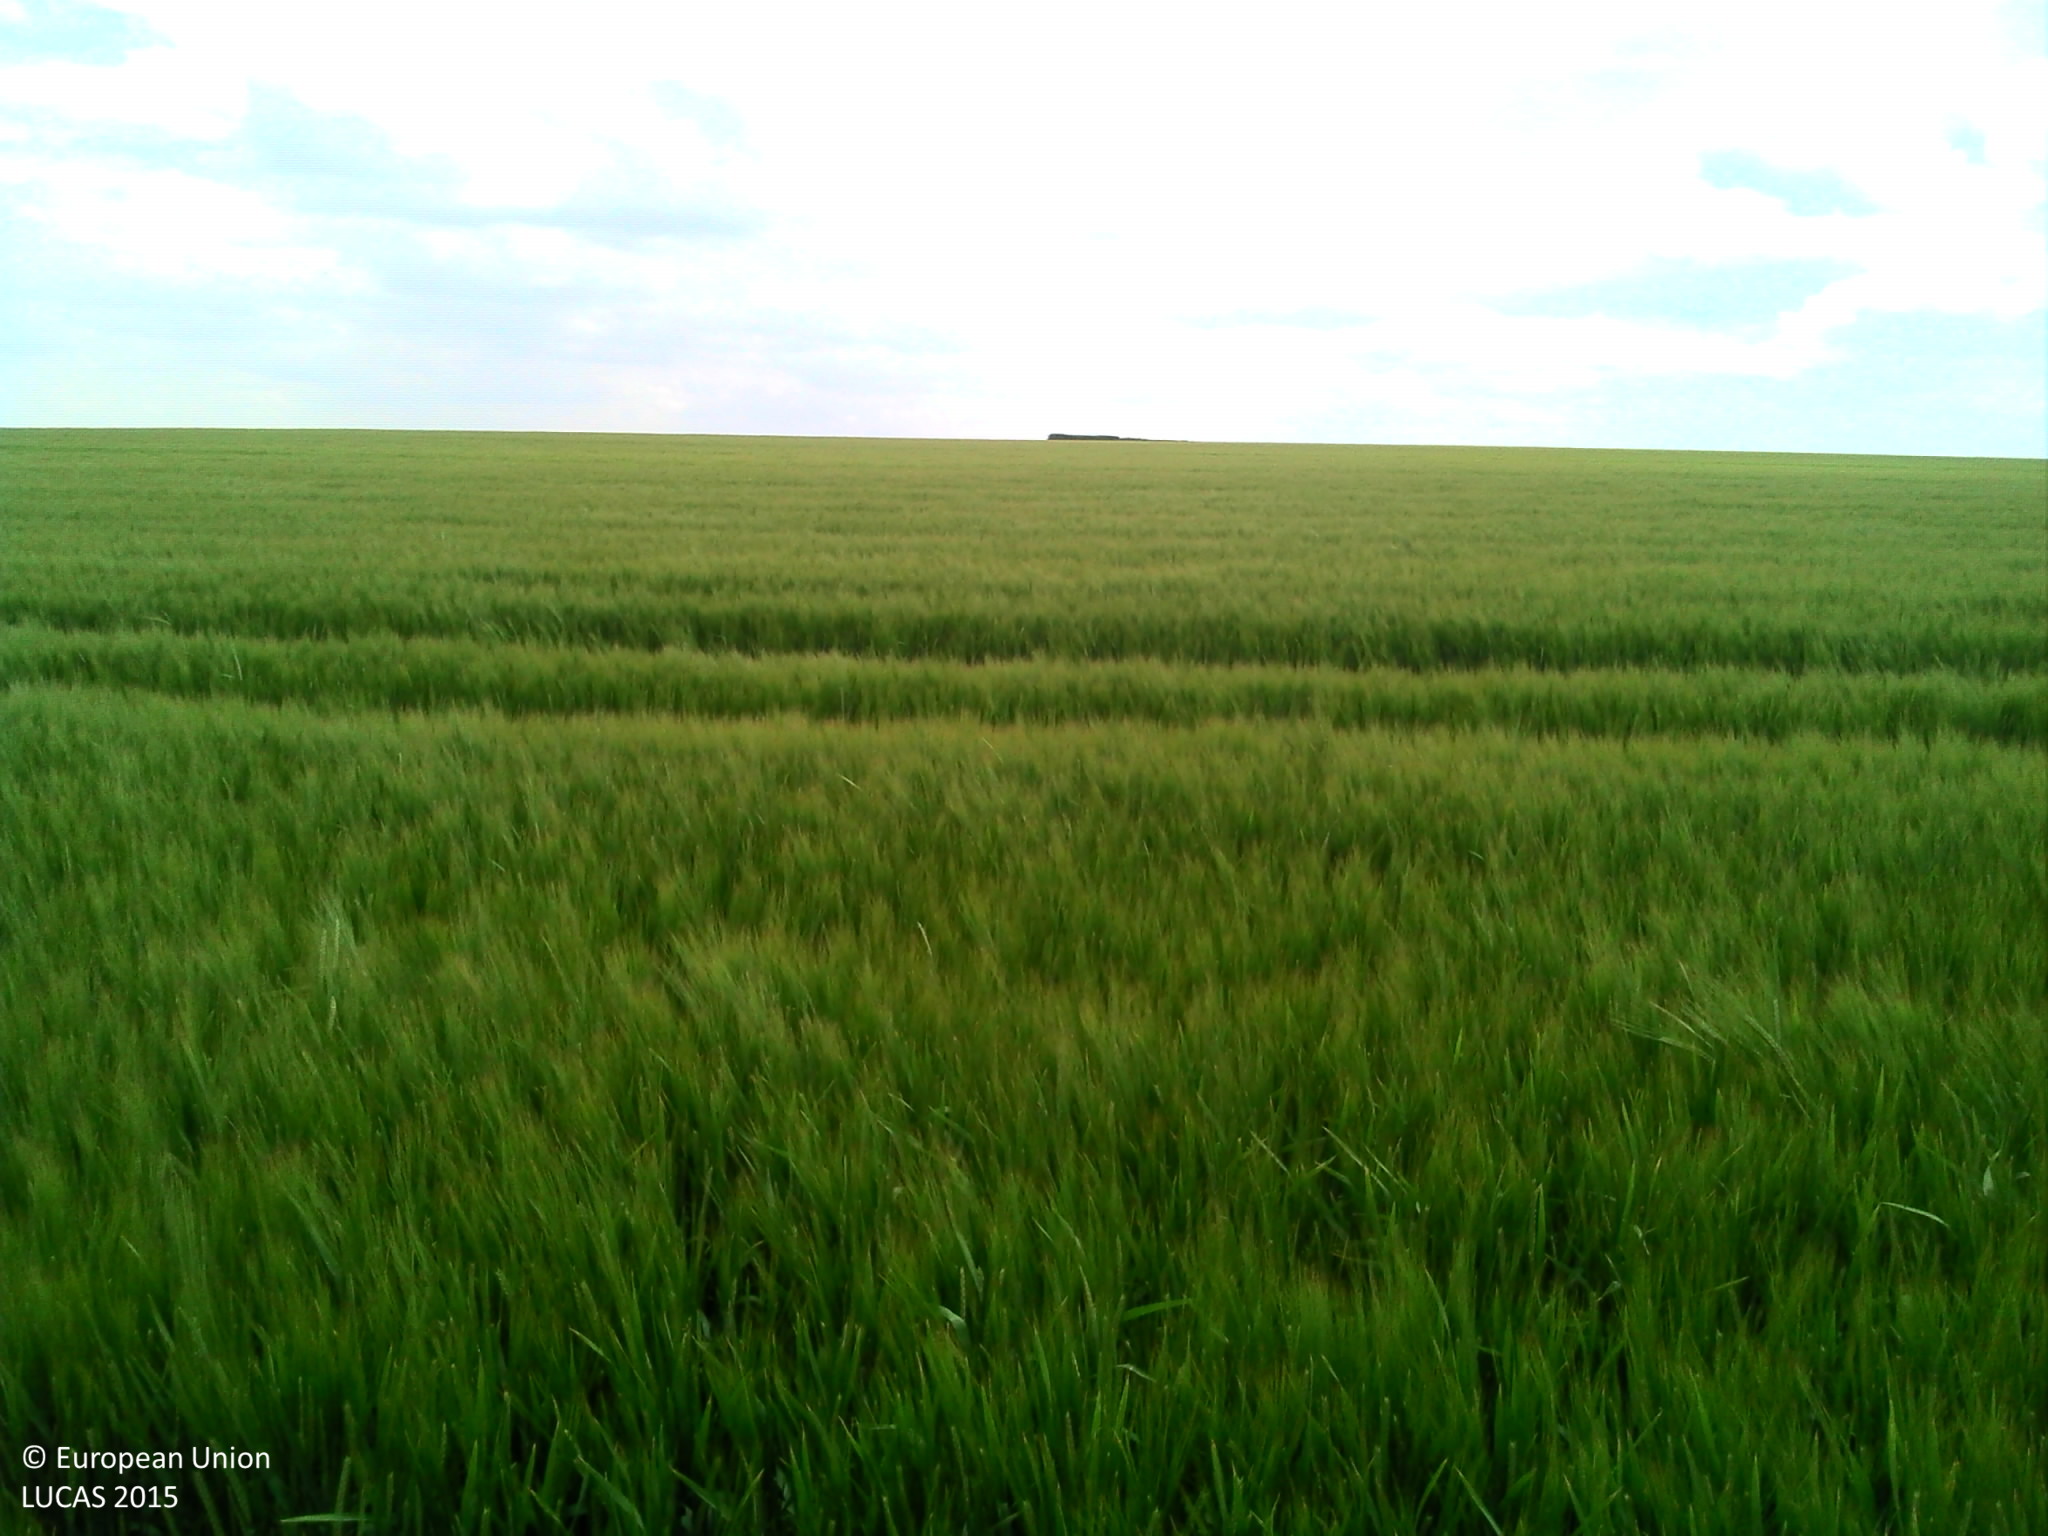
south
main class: Cropland
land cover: Barley
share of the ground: > 75 %
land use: Agriculture (excluding fallow land and kitchen gardens)
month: June
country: FR
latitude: 49.3428
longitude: 3.7037
